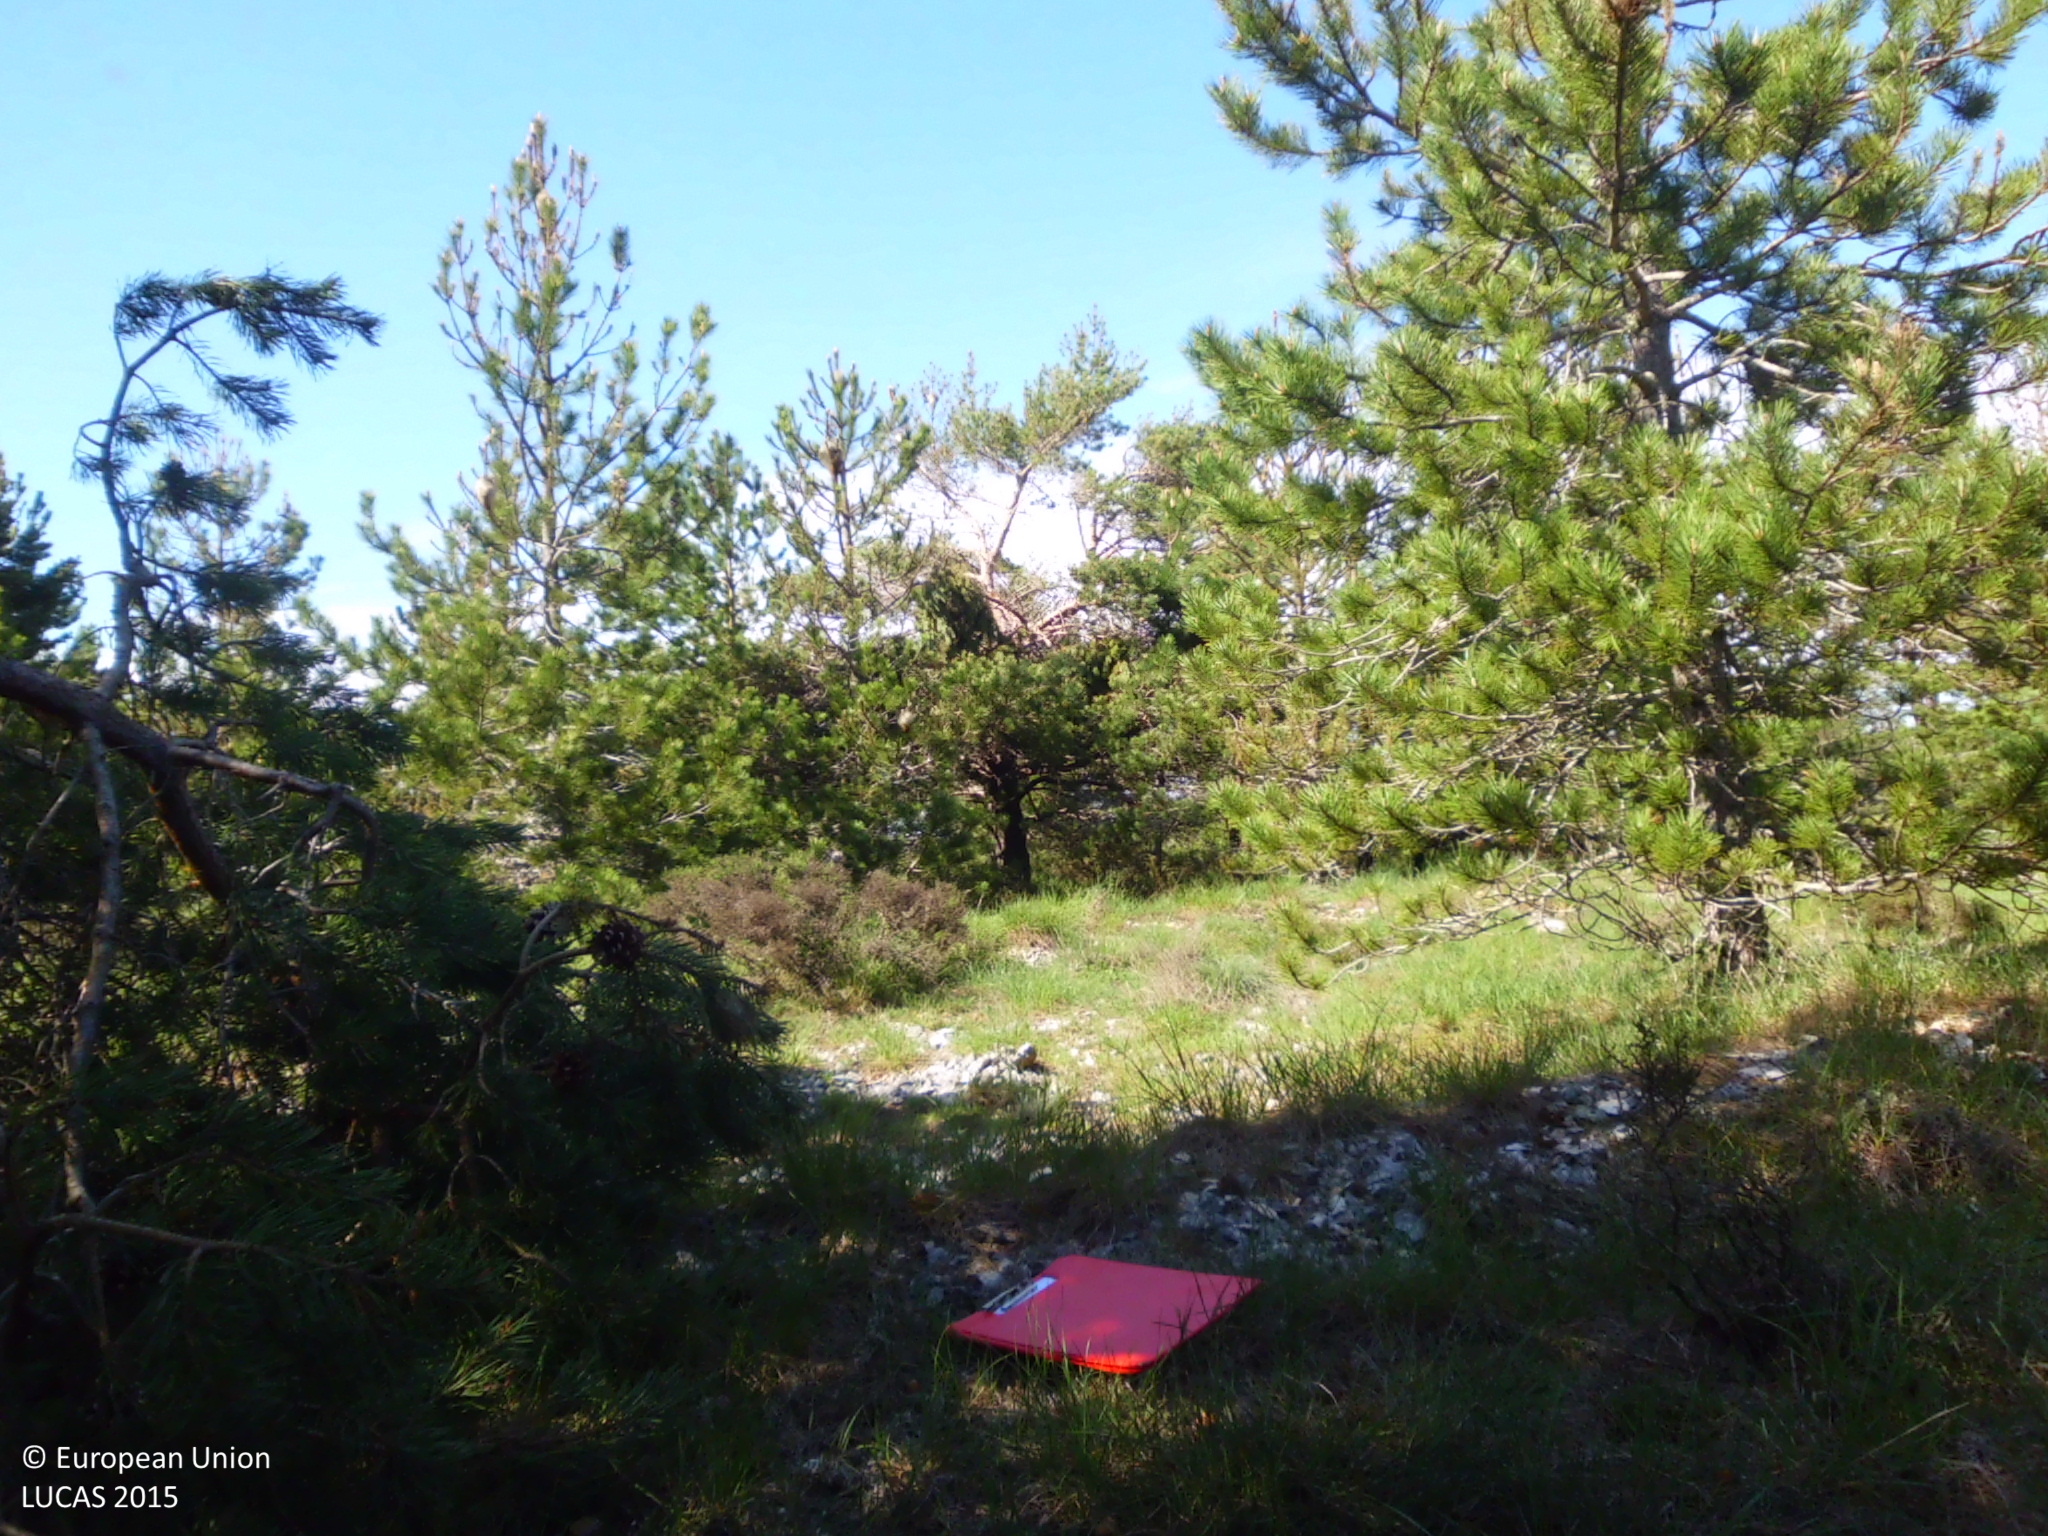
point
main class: Woodland
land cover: Pine dominated coniferous woodland
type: coniferous forest of the mediterranean region
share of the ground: > 75 %
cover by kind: coniferous forest trees 50 %, herbaceous plants 30 %, shrubs 15 %, consolidated bare surface 5 %
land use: Forestry
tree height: < 5 m
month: May
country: ES
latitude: 42.6681
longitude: -3.8415
